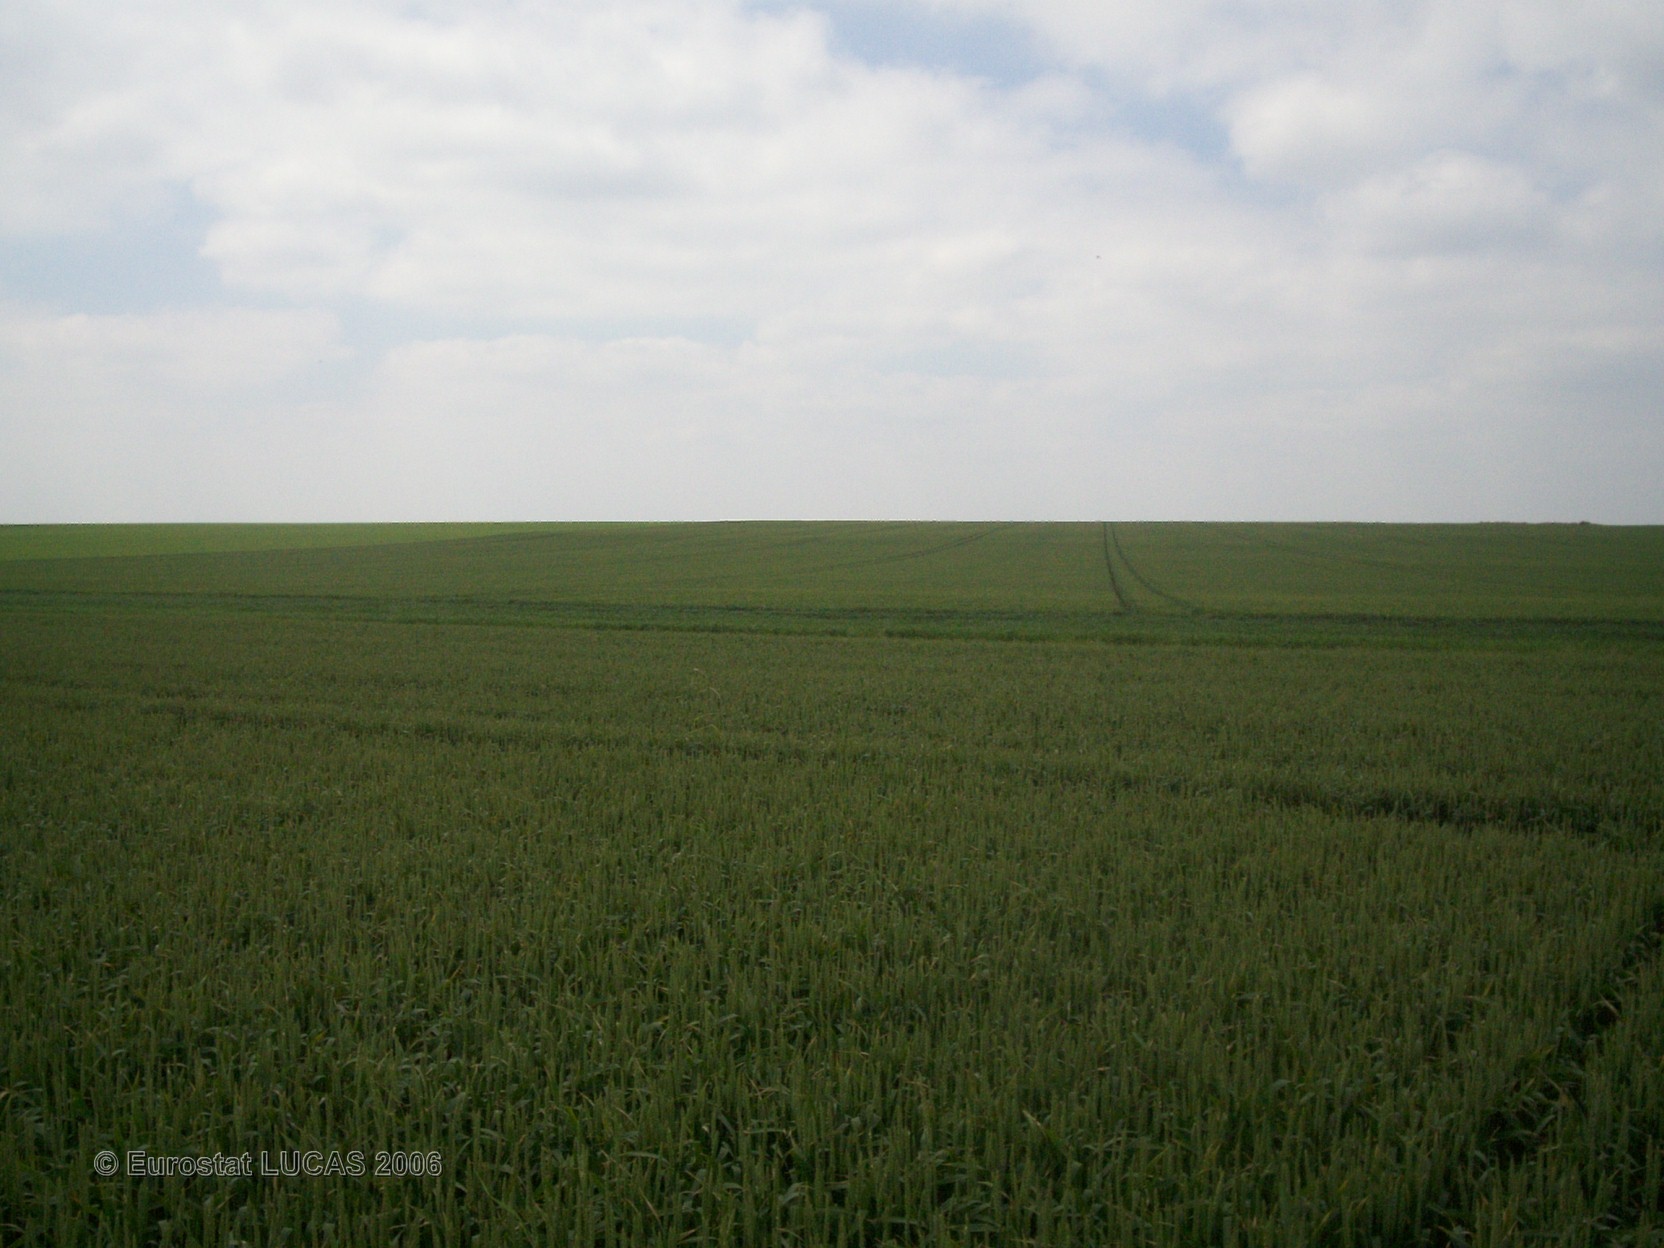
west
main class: Cropland
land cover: Common wheat
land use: Agriculture (excluding fallow land and kitchen gardens)
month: June
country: FR
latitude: 49.9268
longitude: 2.6194
